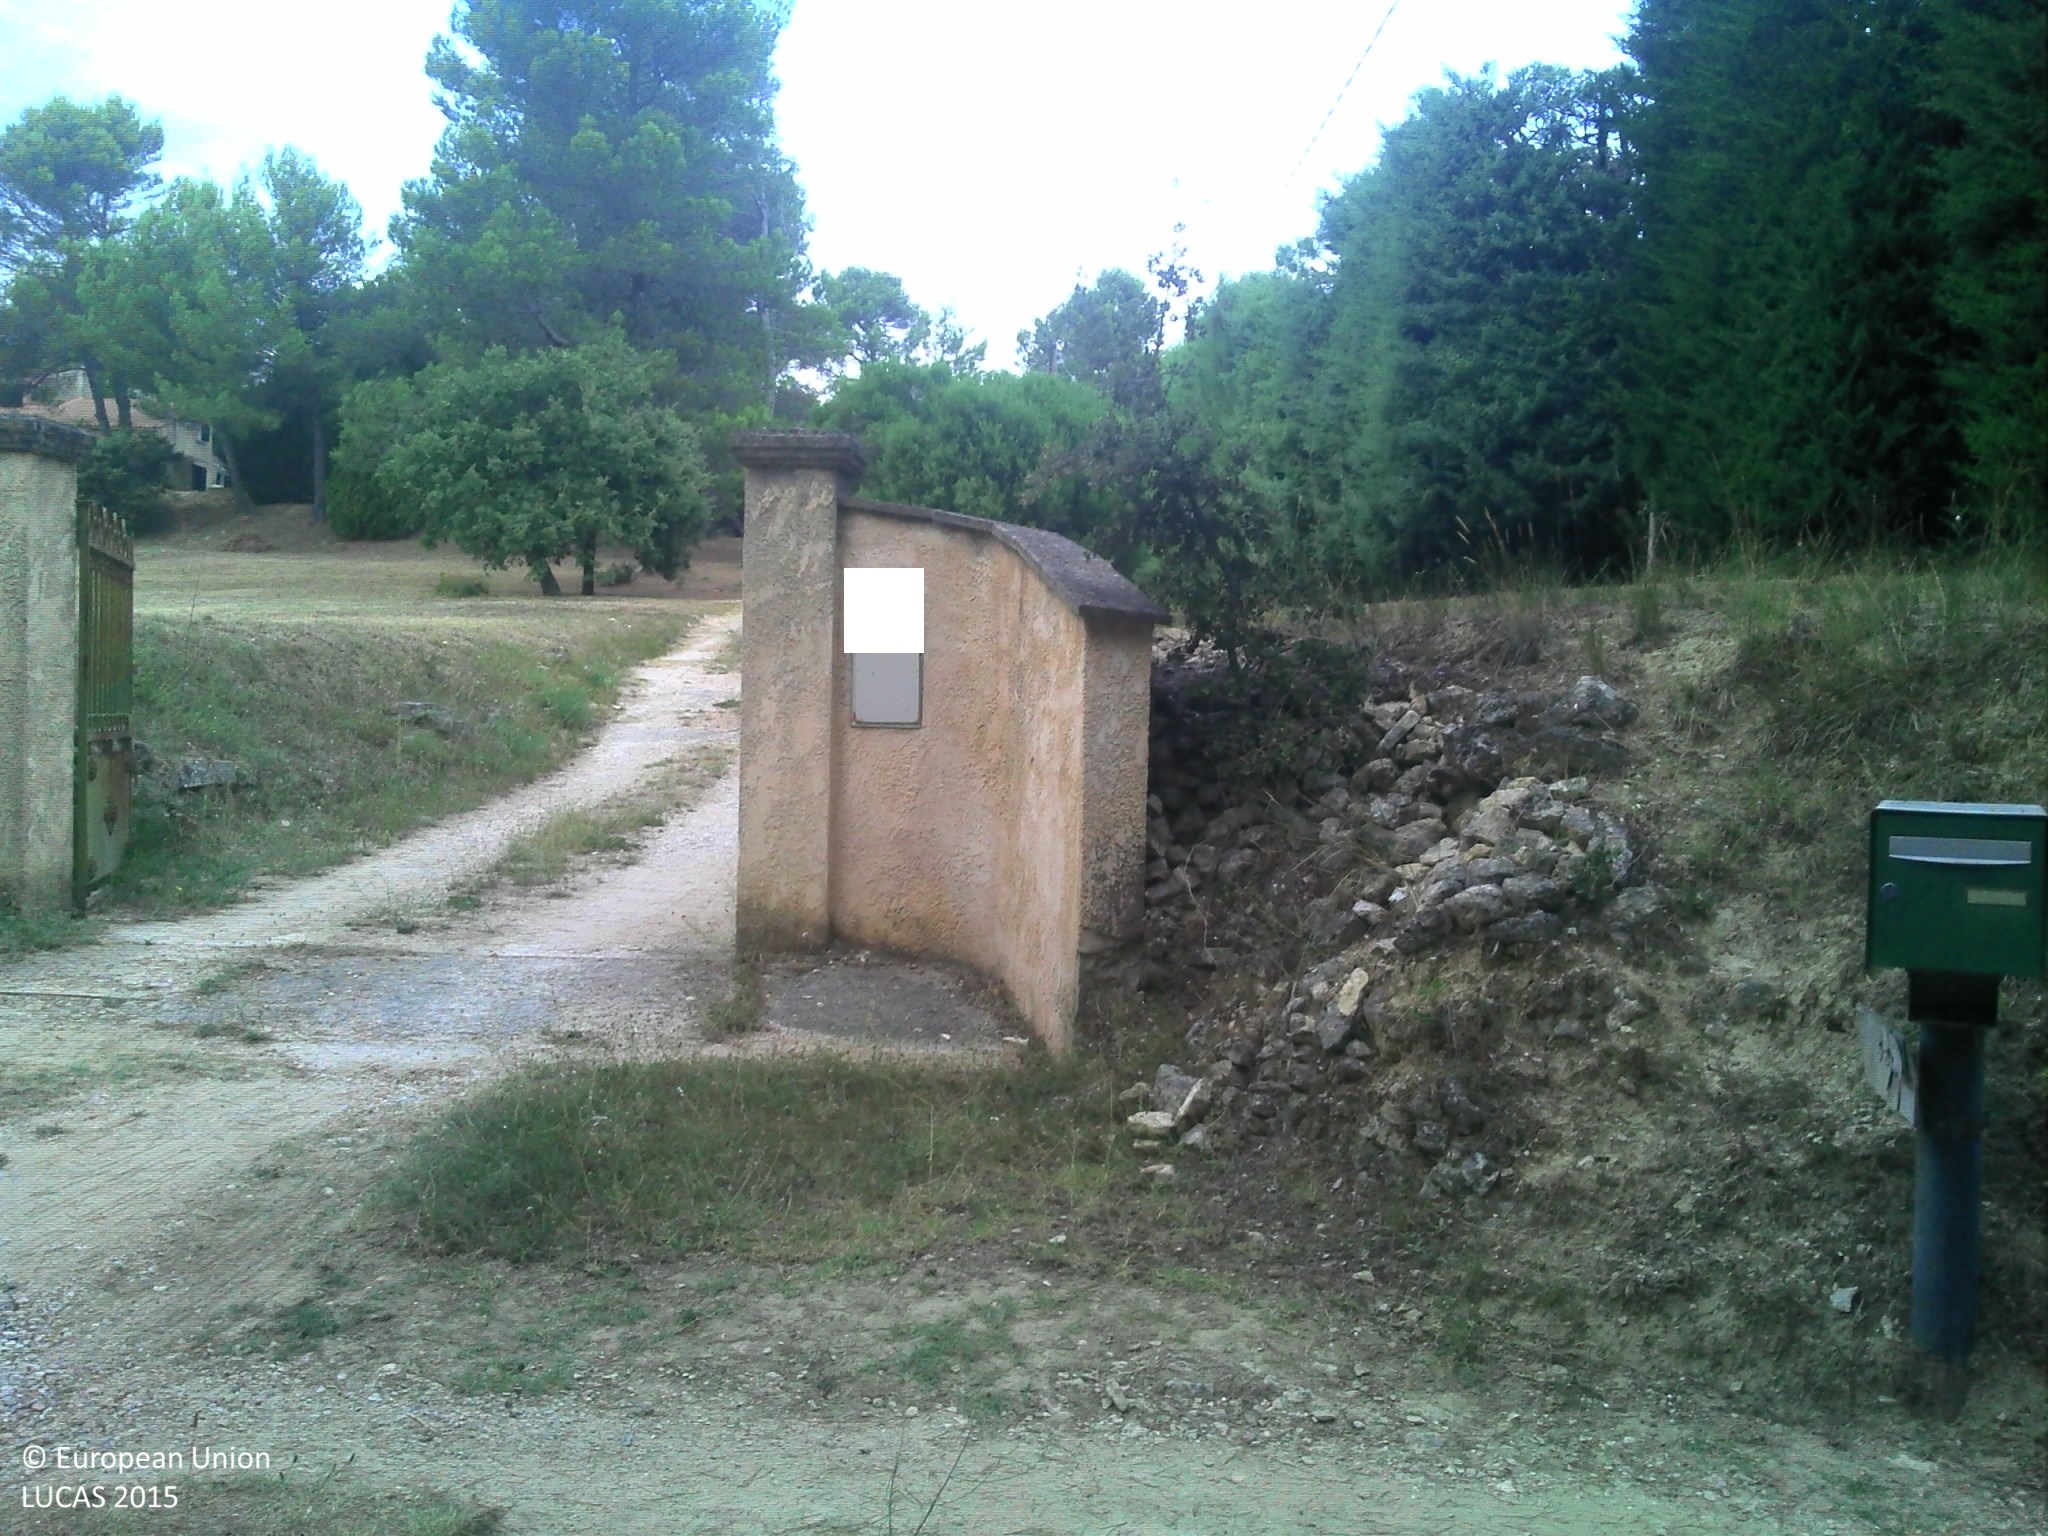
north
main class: Grassland
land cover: Grassland with sparse tree/shrub cover
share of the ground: > 75 %
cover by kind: herbaceous plants 95 %, broadleaved forest trees 5 %
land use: Residential
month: August
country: FR
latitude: 43.6517
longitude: 5.3847
